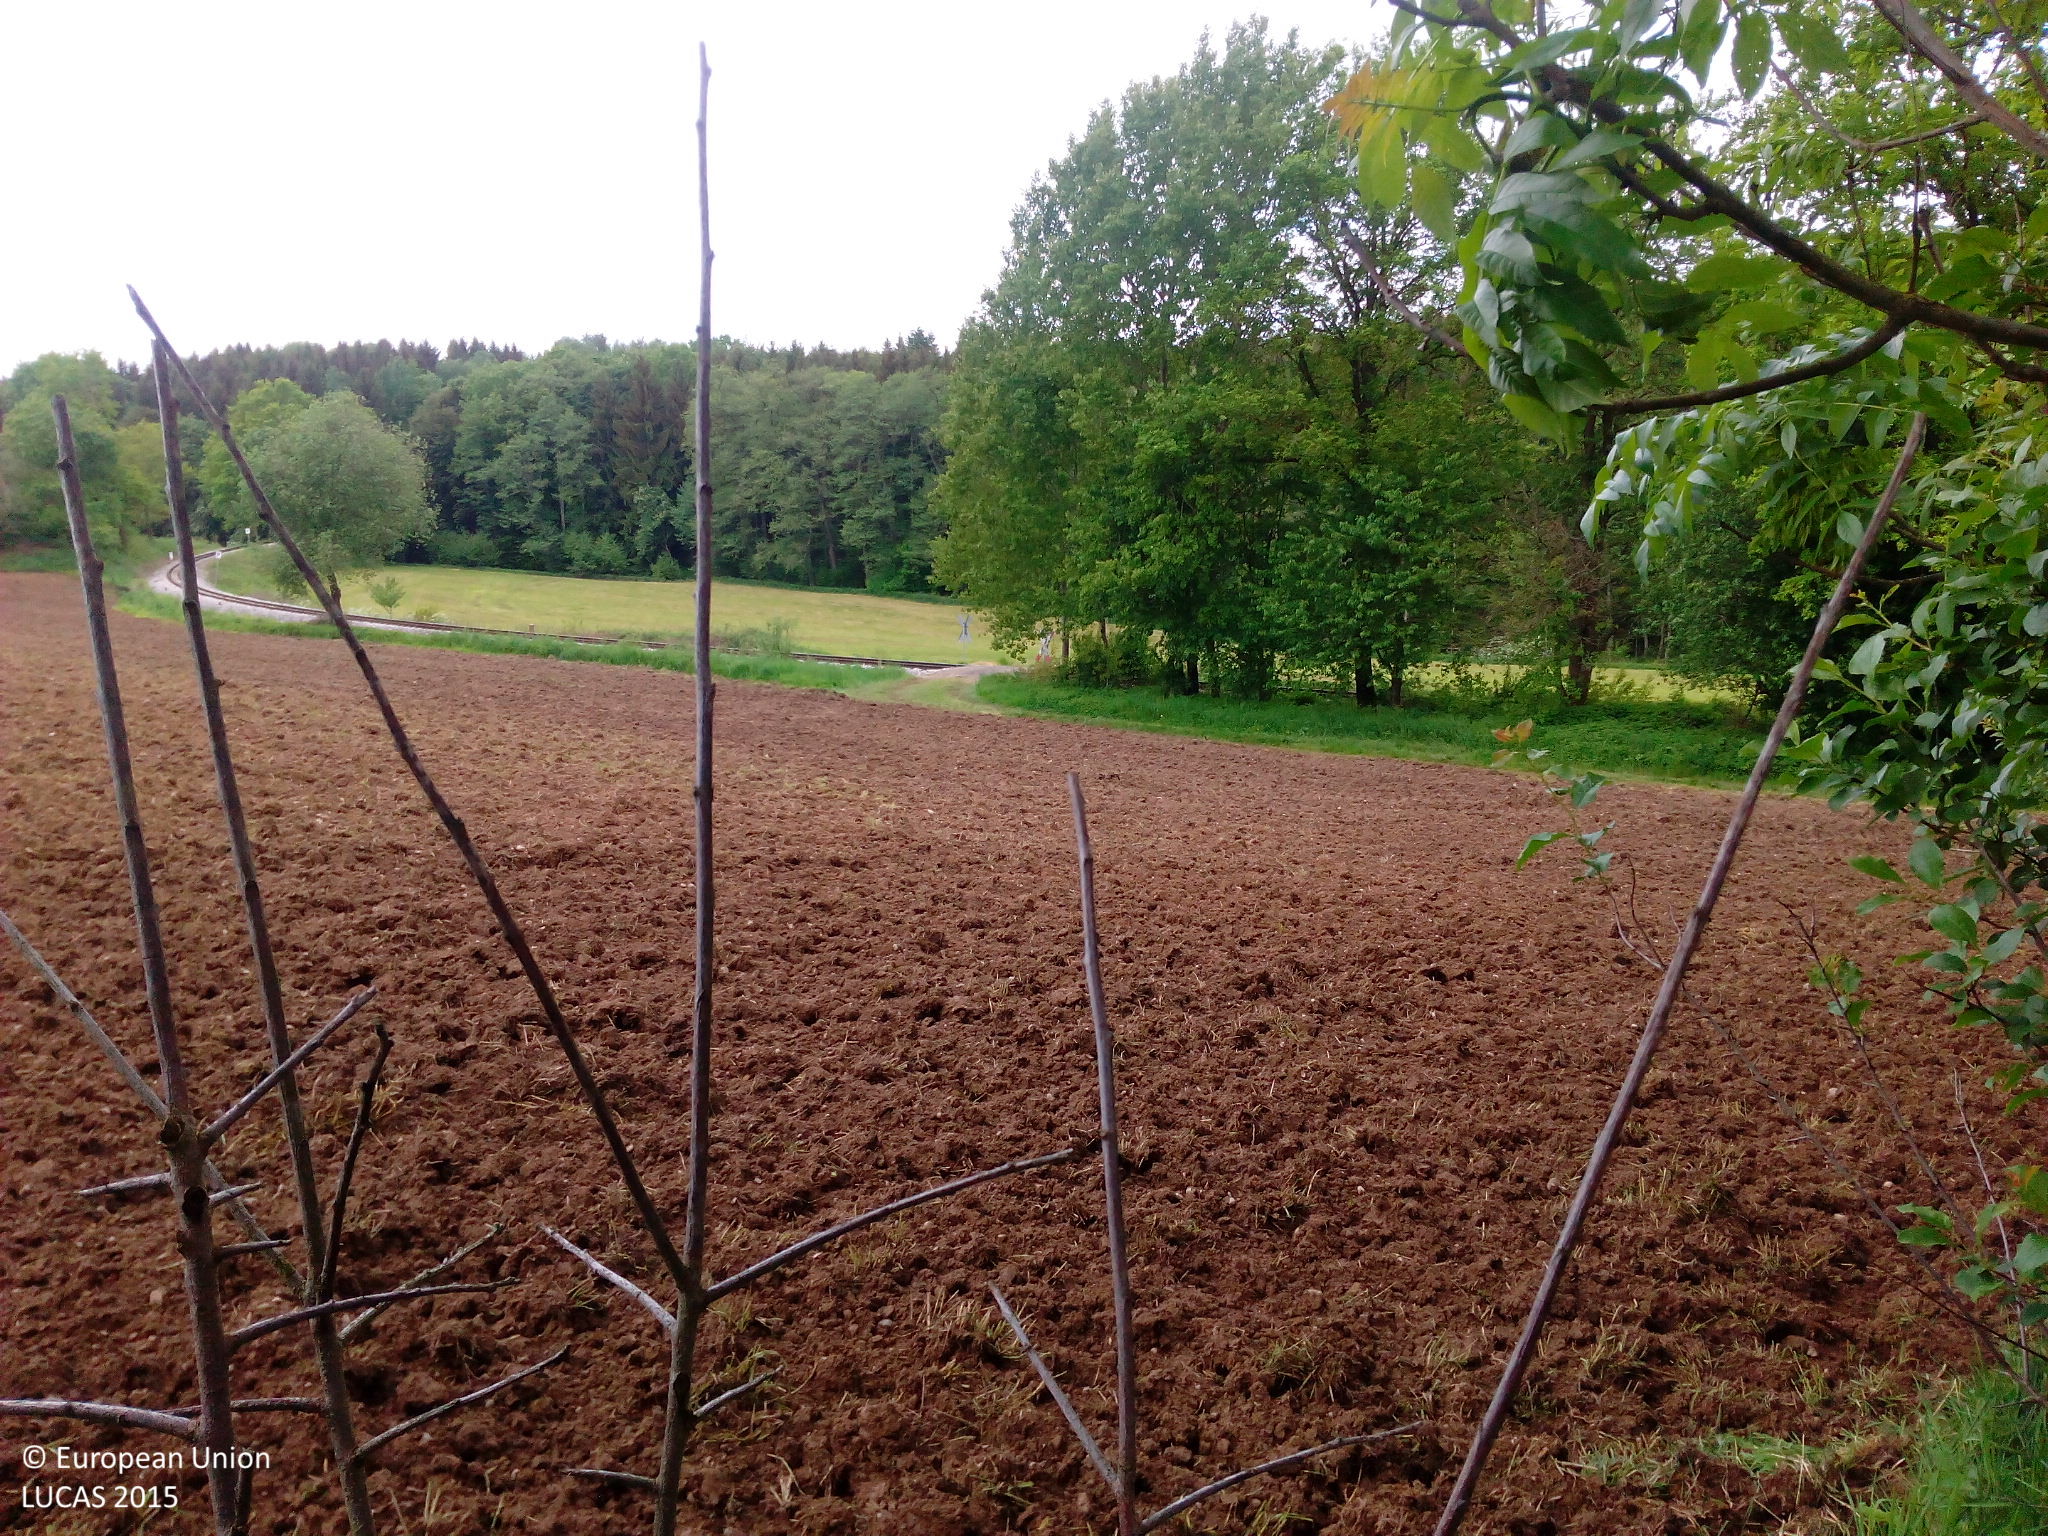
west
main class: Grassland
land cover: Grassland with sparse tree/shrub cover
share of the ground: > 75 %
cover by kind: herbaceous plants 95 %, broadleaved forest trees 5 %
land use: Residential
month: May
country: DE
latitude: 48.1155
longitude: 9.9329
